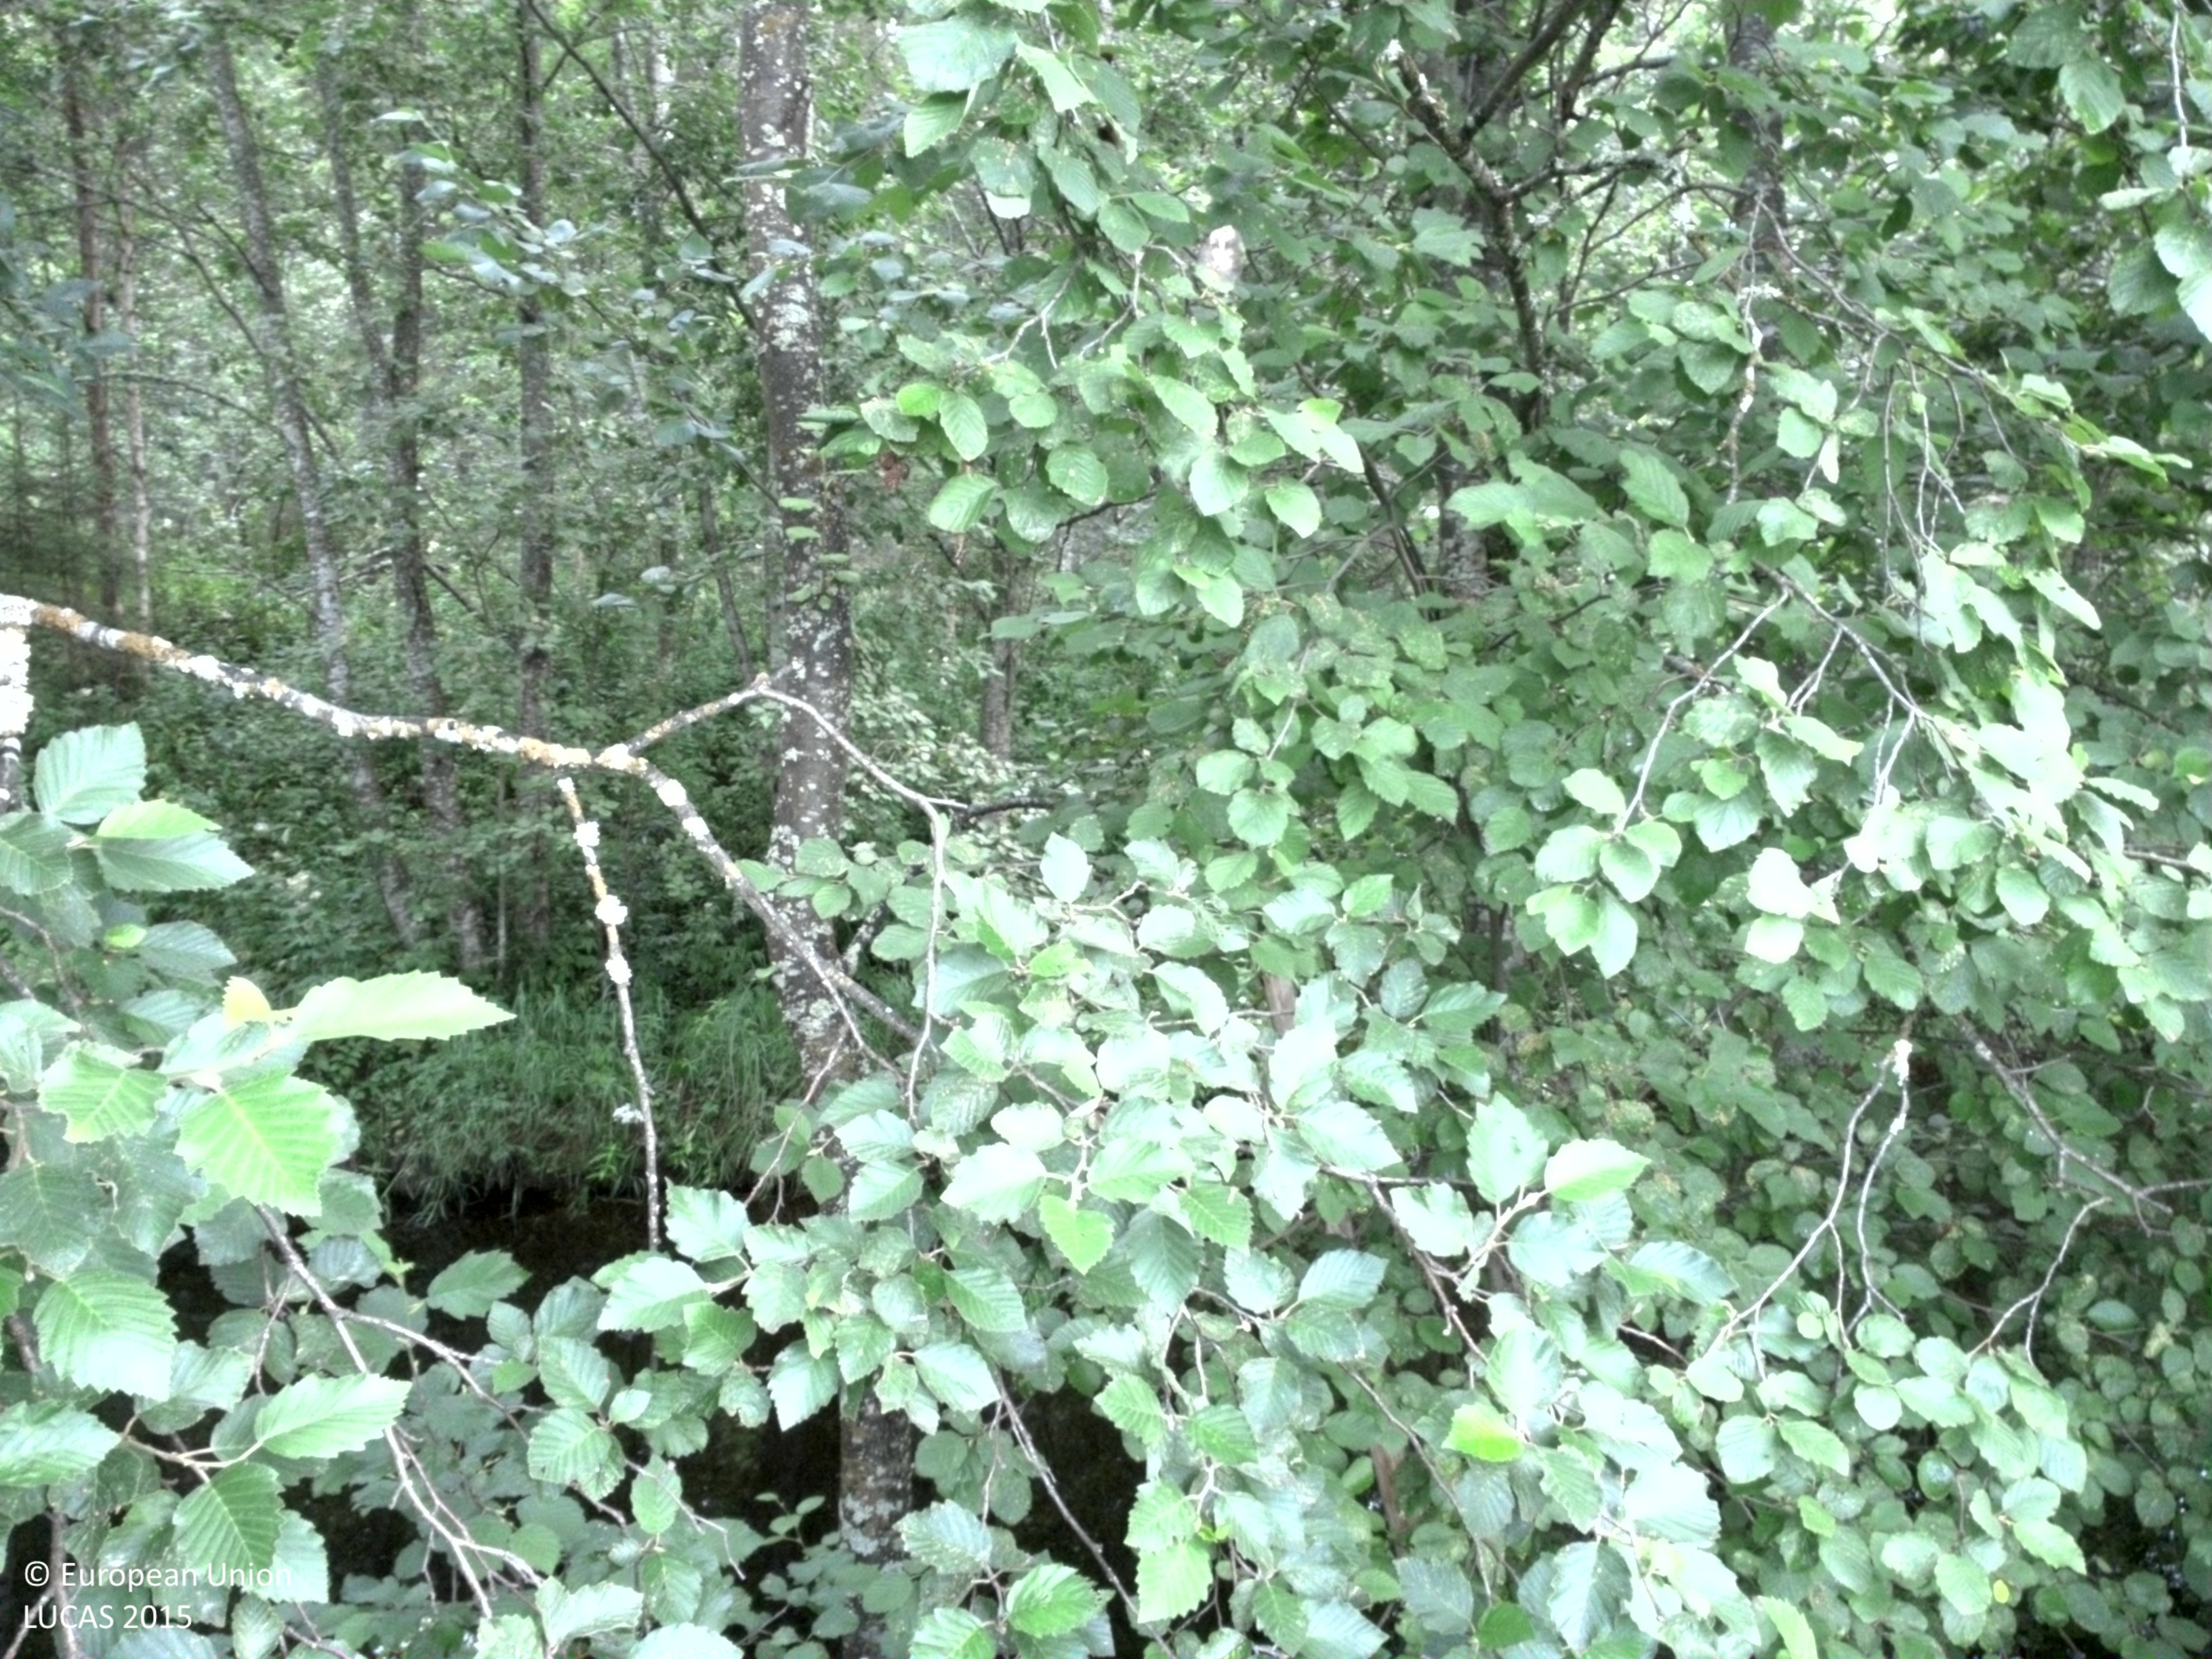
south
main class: Woodland
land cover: Broadleaved woodland
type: boreal forest
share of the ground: > 75 %
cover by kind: broadleaved forest trees 70 %, herbaceous plants 15 %, coniferous forest trees 10 %, shrubs 5 %
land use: Semi-natural and natural areas not in use
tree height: > 5 m
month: August
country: SE
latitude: 64.6964
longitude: 20.6495
